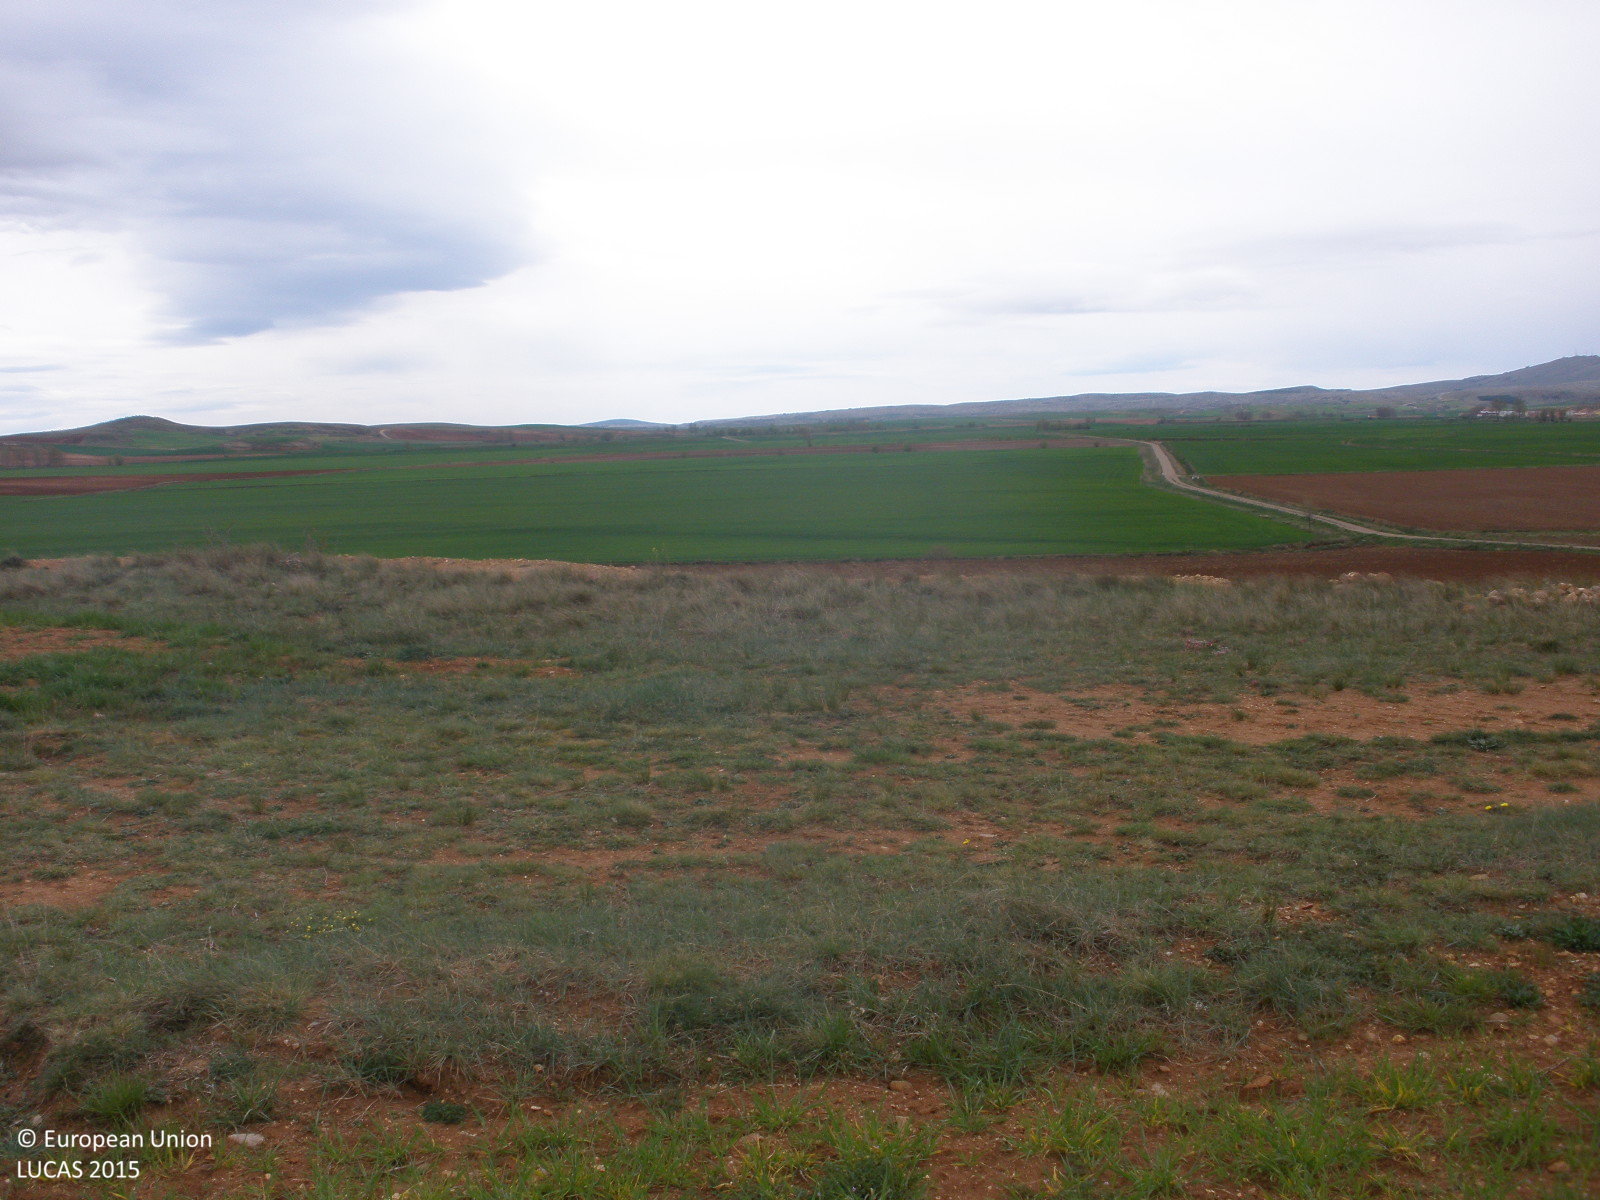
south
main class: Cropland
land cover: Barley
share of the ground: 50 - 75 %
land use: Agriculture (excluding fallow land and kitchen gardens)
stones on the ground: 10 - 25 %
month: May
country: ES
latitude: 40.5226
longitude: -0.8346
